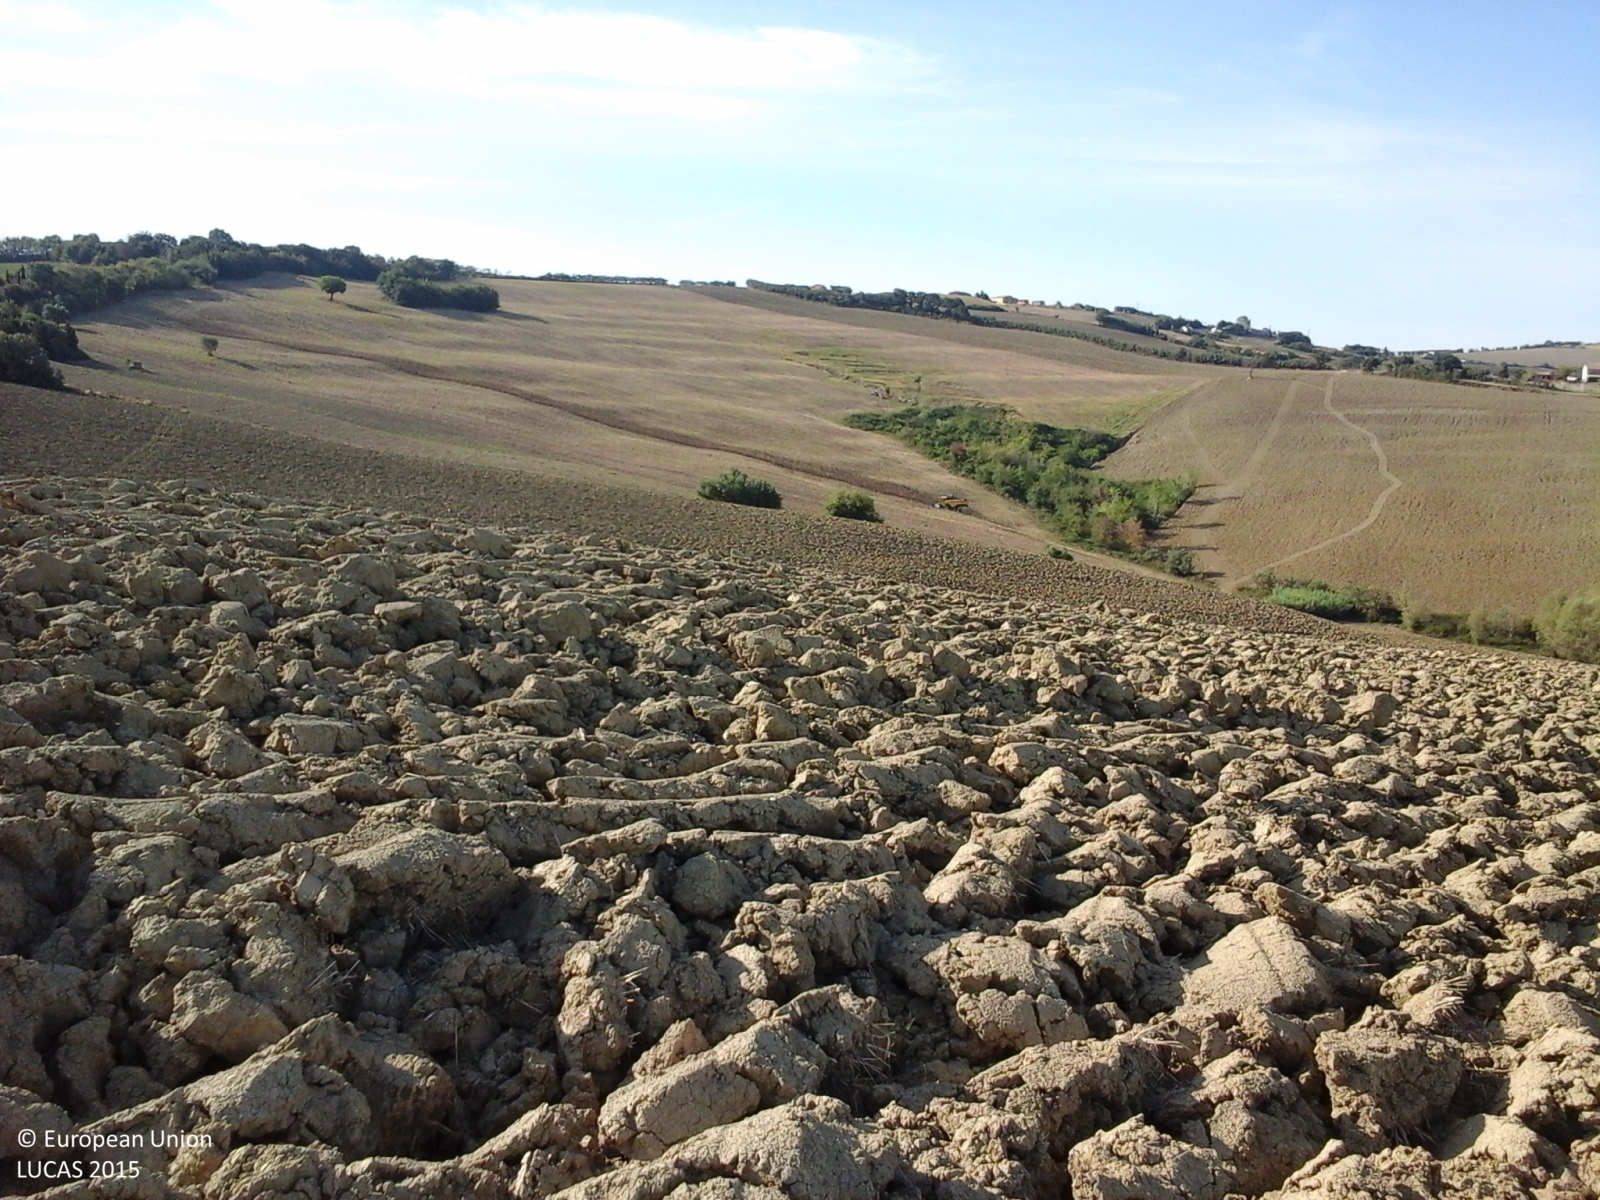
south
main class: Cropland
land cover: Durum wheat
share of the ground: < 10 %
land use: Agriculture (excluding fallow land and kitchen gardens)
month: September
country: IT
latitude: 43.7285
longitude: 13.0343
